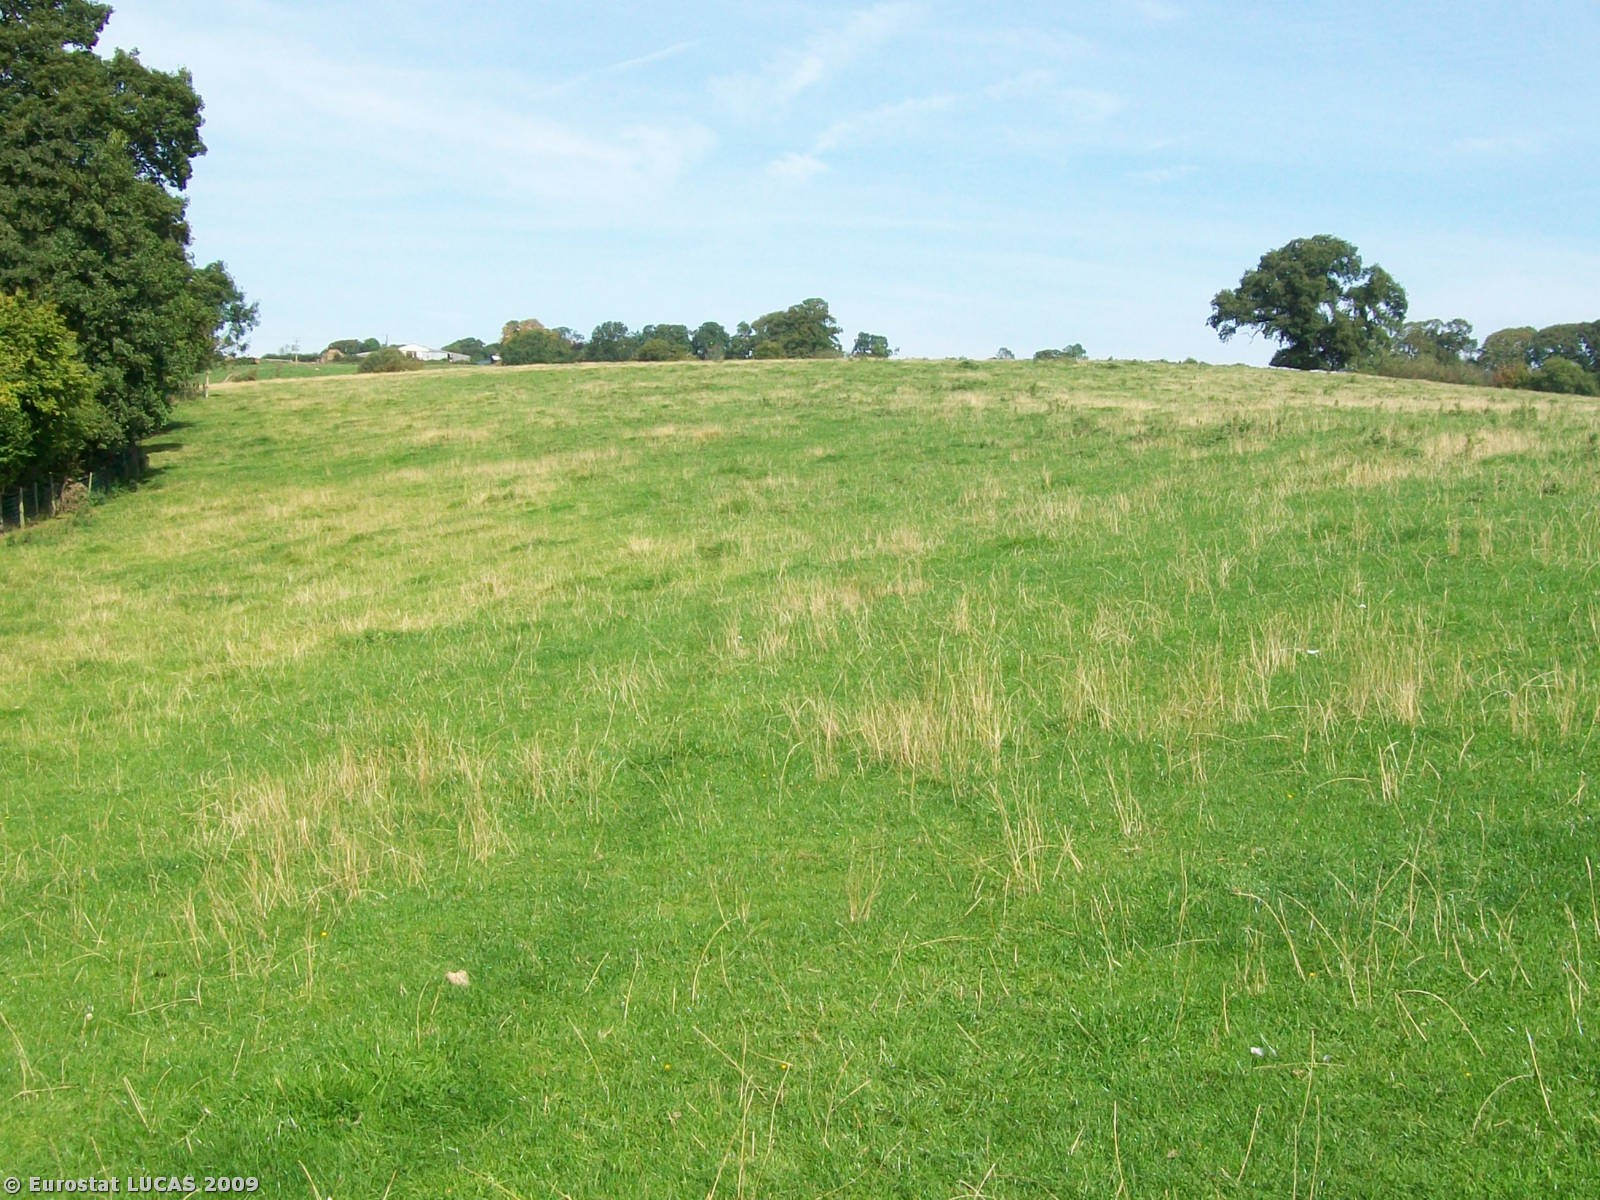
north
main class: Grassland
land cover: Grassland without tree/shrub cover
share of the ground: > 75 %
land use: Agriculture (excluding fallow land and kitchen gardens)
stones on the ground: < 10 %
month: September
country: GB
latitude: 52.2652
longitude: -2.4470
